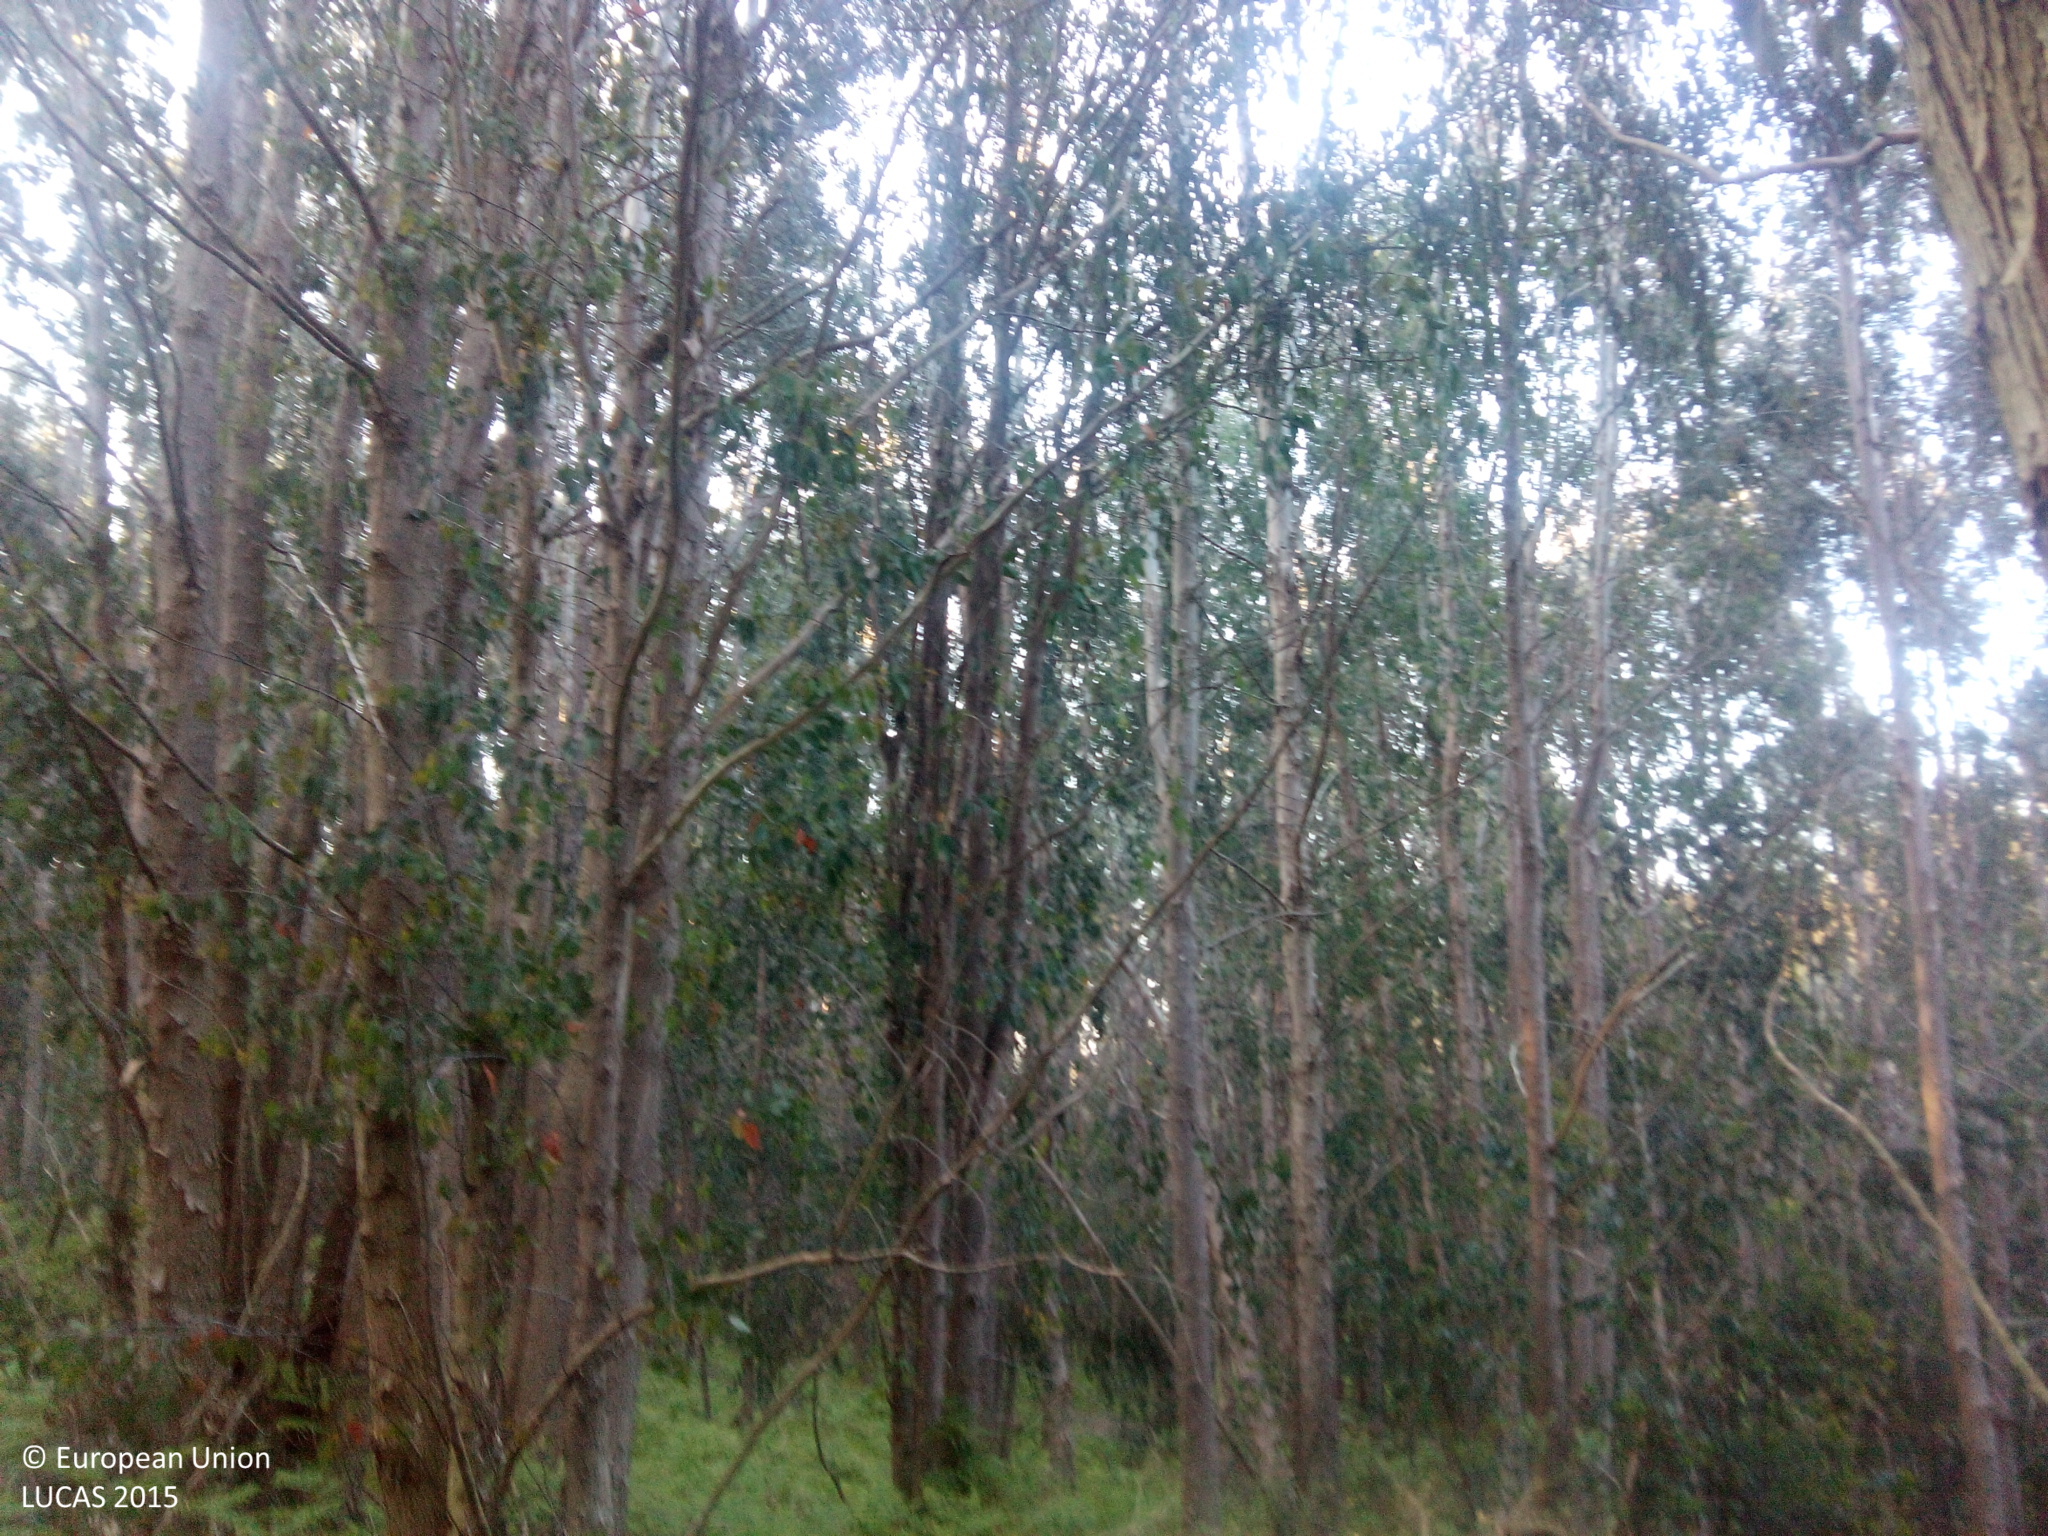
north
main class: Woodland
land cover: Broadleaved woodland
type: exotic forest
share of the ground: > 75 %
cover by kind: broadleaved forest trees 70 %, shrubs 20 %, herbaceous plants 10 %
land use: Forestry
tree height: > 5 m
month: June
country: ES
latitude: 42.2218
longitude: -8.3218
